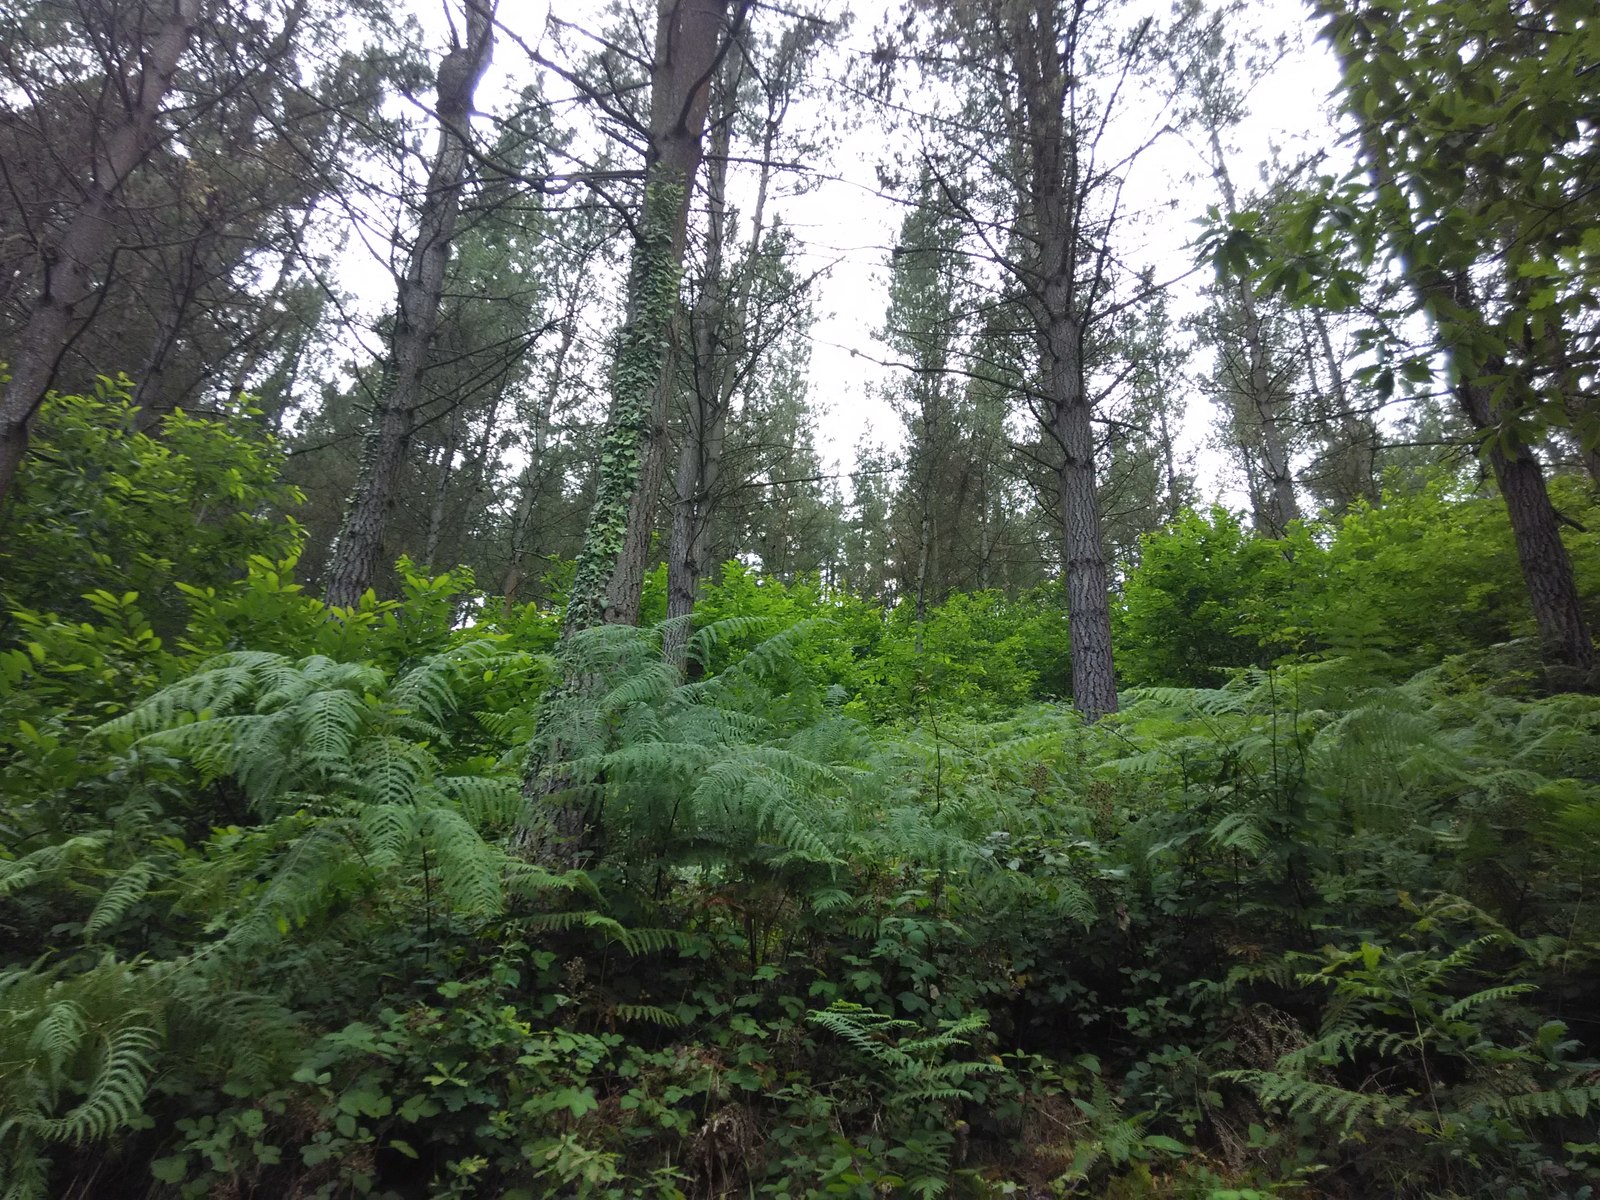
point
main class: Woodland
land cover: Pine dominated coniferous woodland
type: exotic forest
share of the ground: > 75 %
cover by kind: coniferous forest trees 100 %
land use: Forestry
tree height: > 5 m
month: July
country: ES
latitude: 43.1793
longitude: -2.4401
